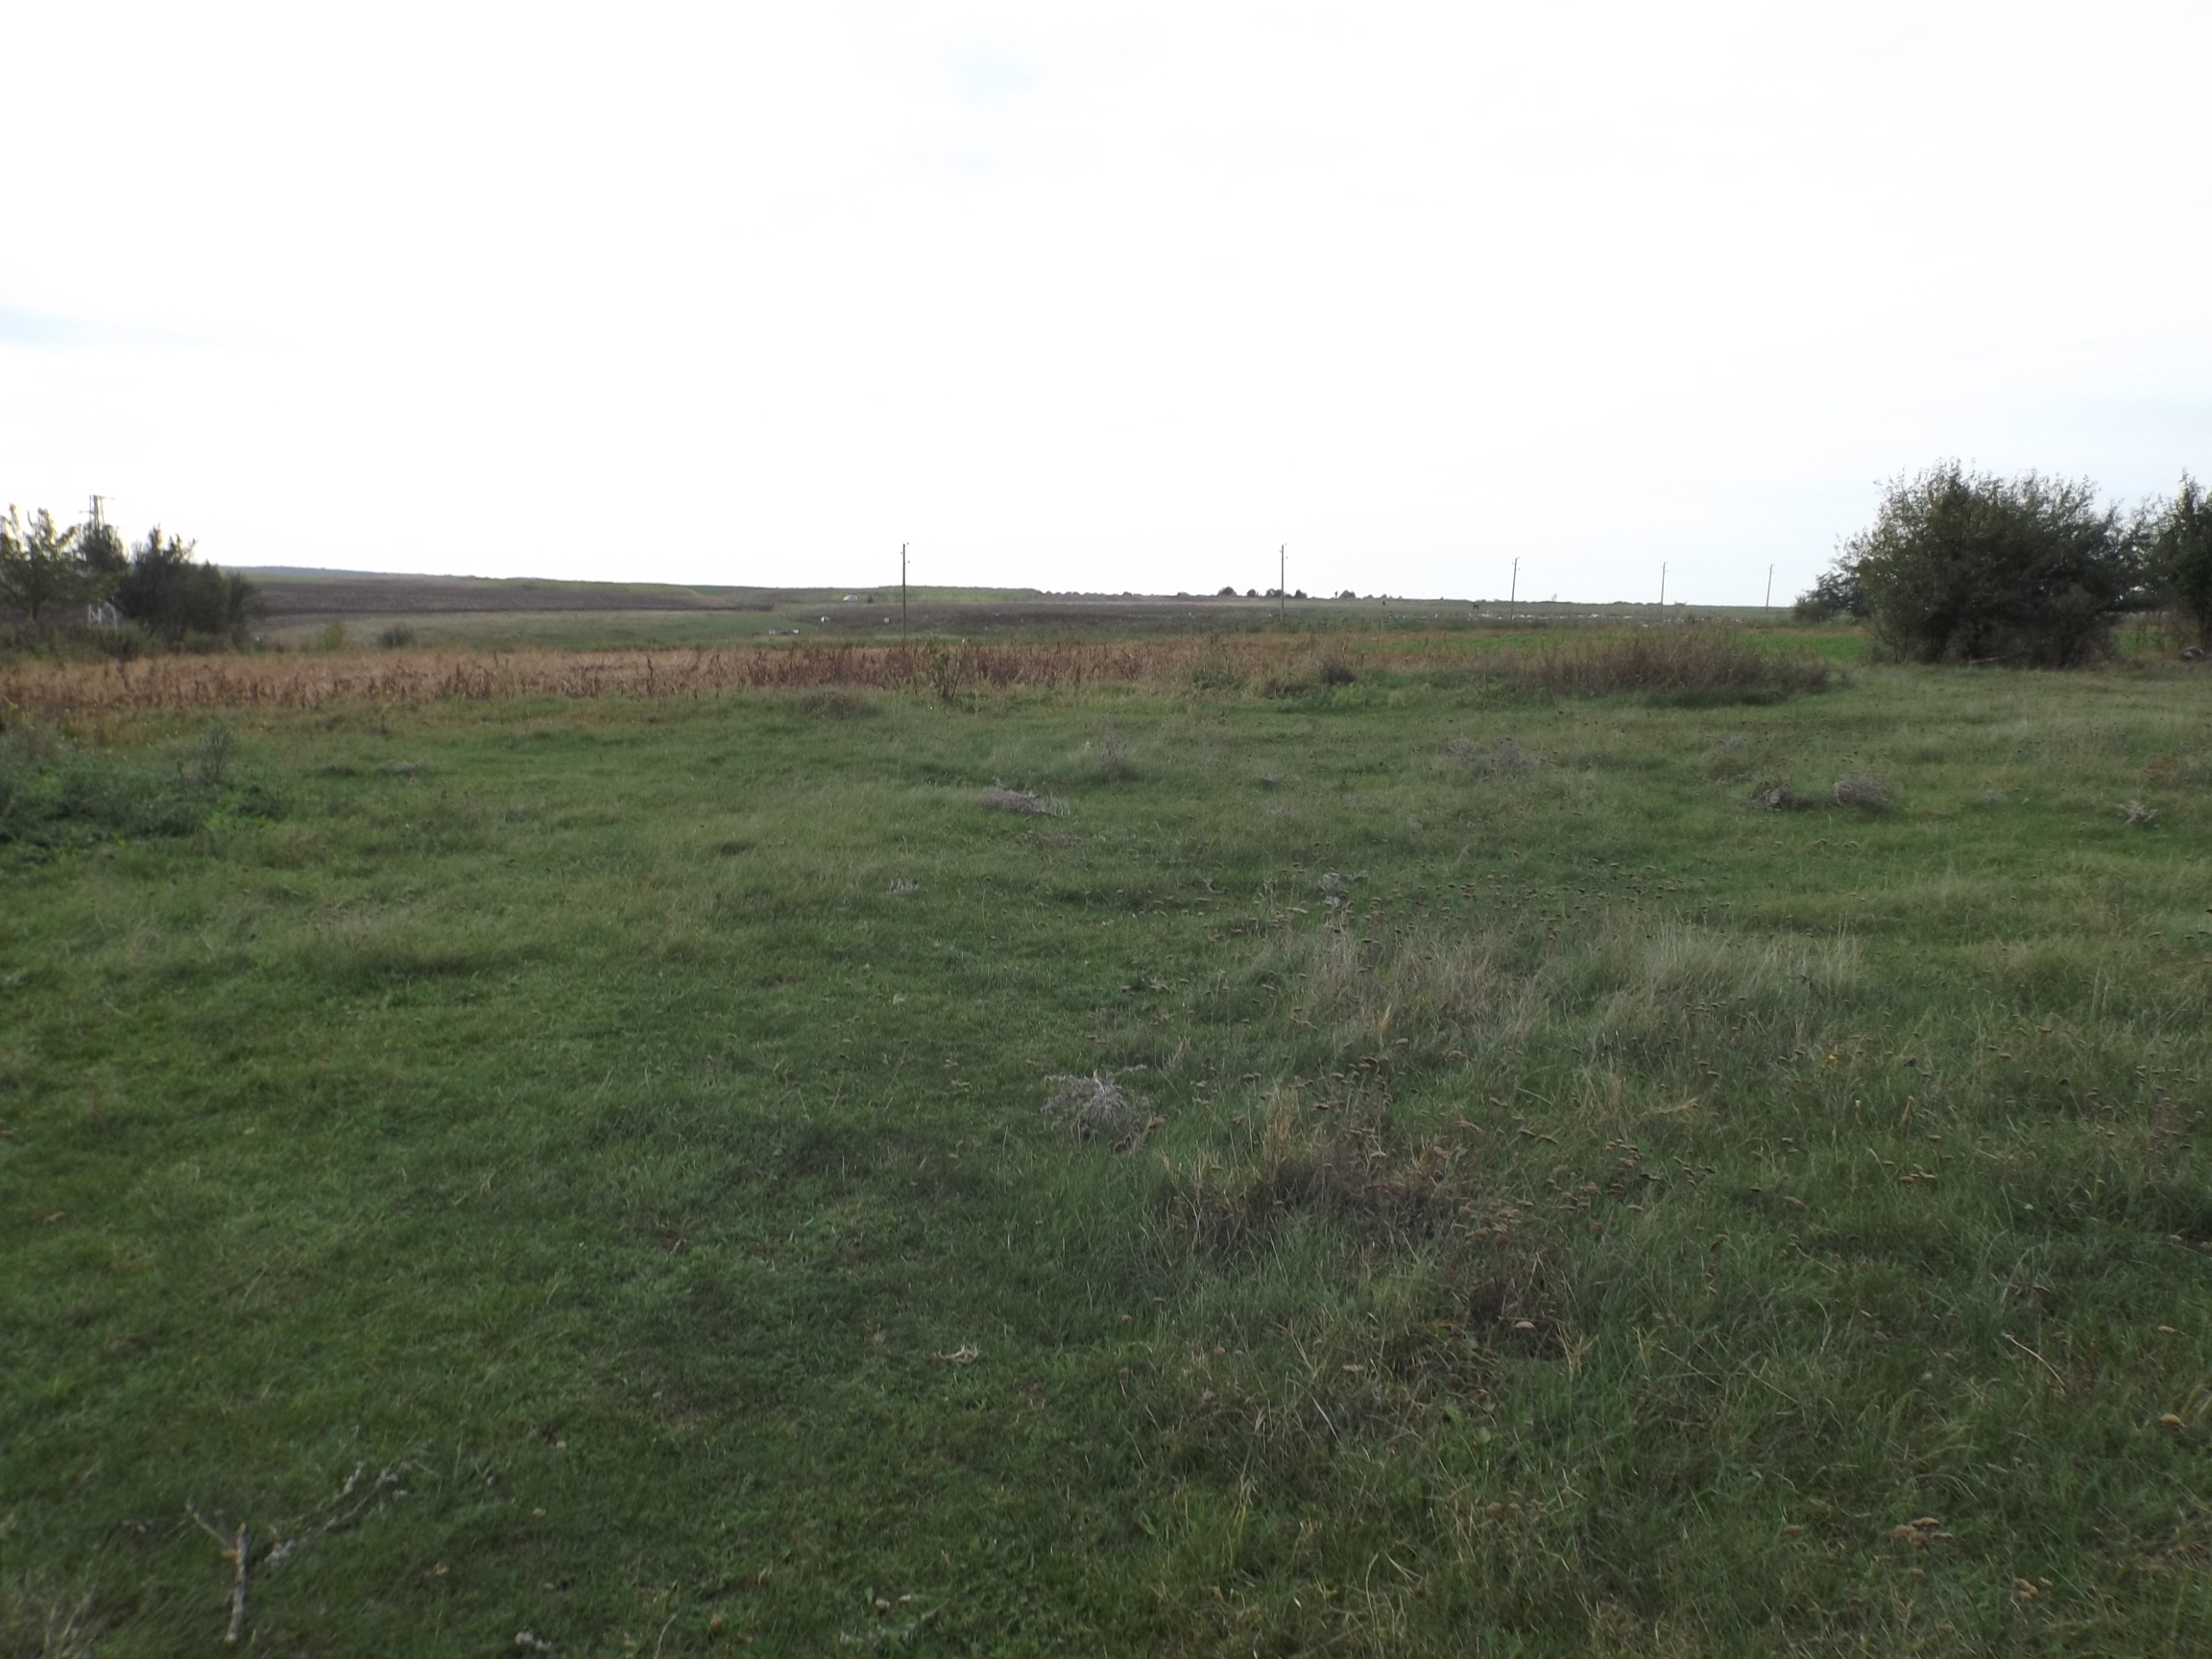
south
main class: Grassland
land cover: Grassland without tree/shrub cover
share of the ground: > 75 %
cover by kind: herbaceous plants 100 %
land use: Agriculture (excluding fallow land and kitchen gardens)
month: October
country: BG
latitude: 43.9141
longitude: 26.8680
